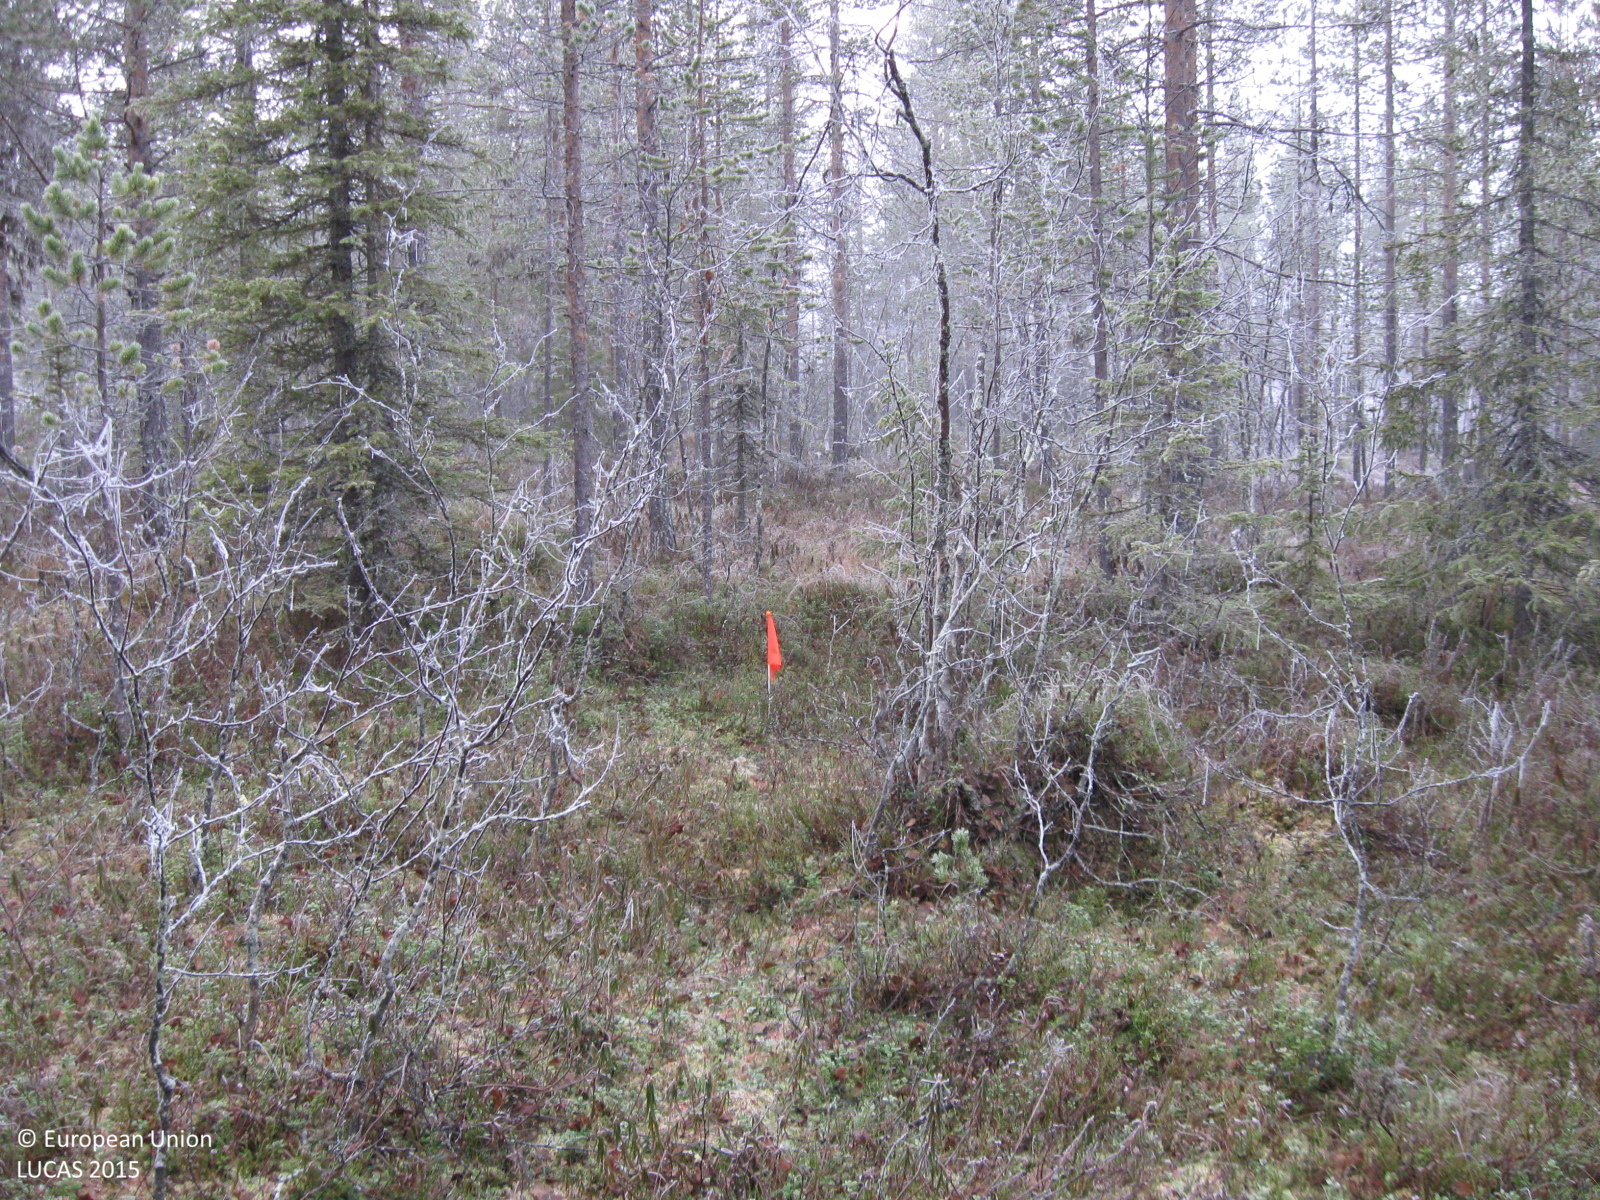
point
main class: Woodland
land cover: Pine dominated coniferous woodland
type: boreal forest
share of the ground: > 75 %
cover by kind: coniferous forest trees 60 %, broadleaved forest trees 15 %, shrubs 10 %, lichens and mosses 10 %, herbaceous plants 5 %
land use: Forestry
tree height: > 5 m
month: October
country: SE
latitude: 66.4168
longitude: 21.7250
